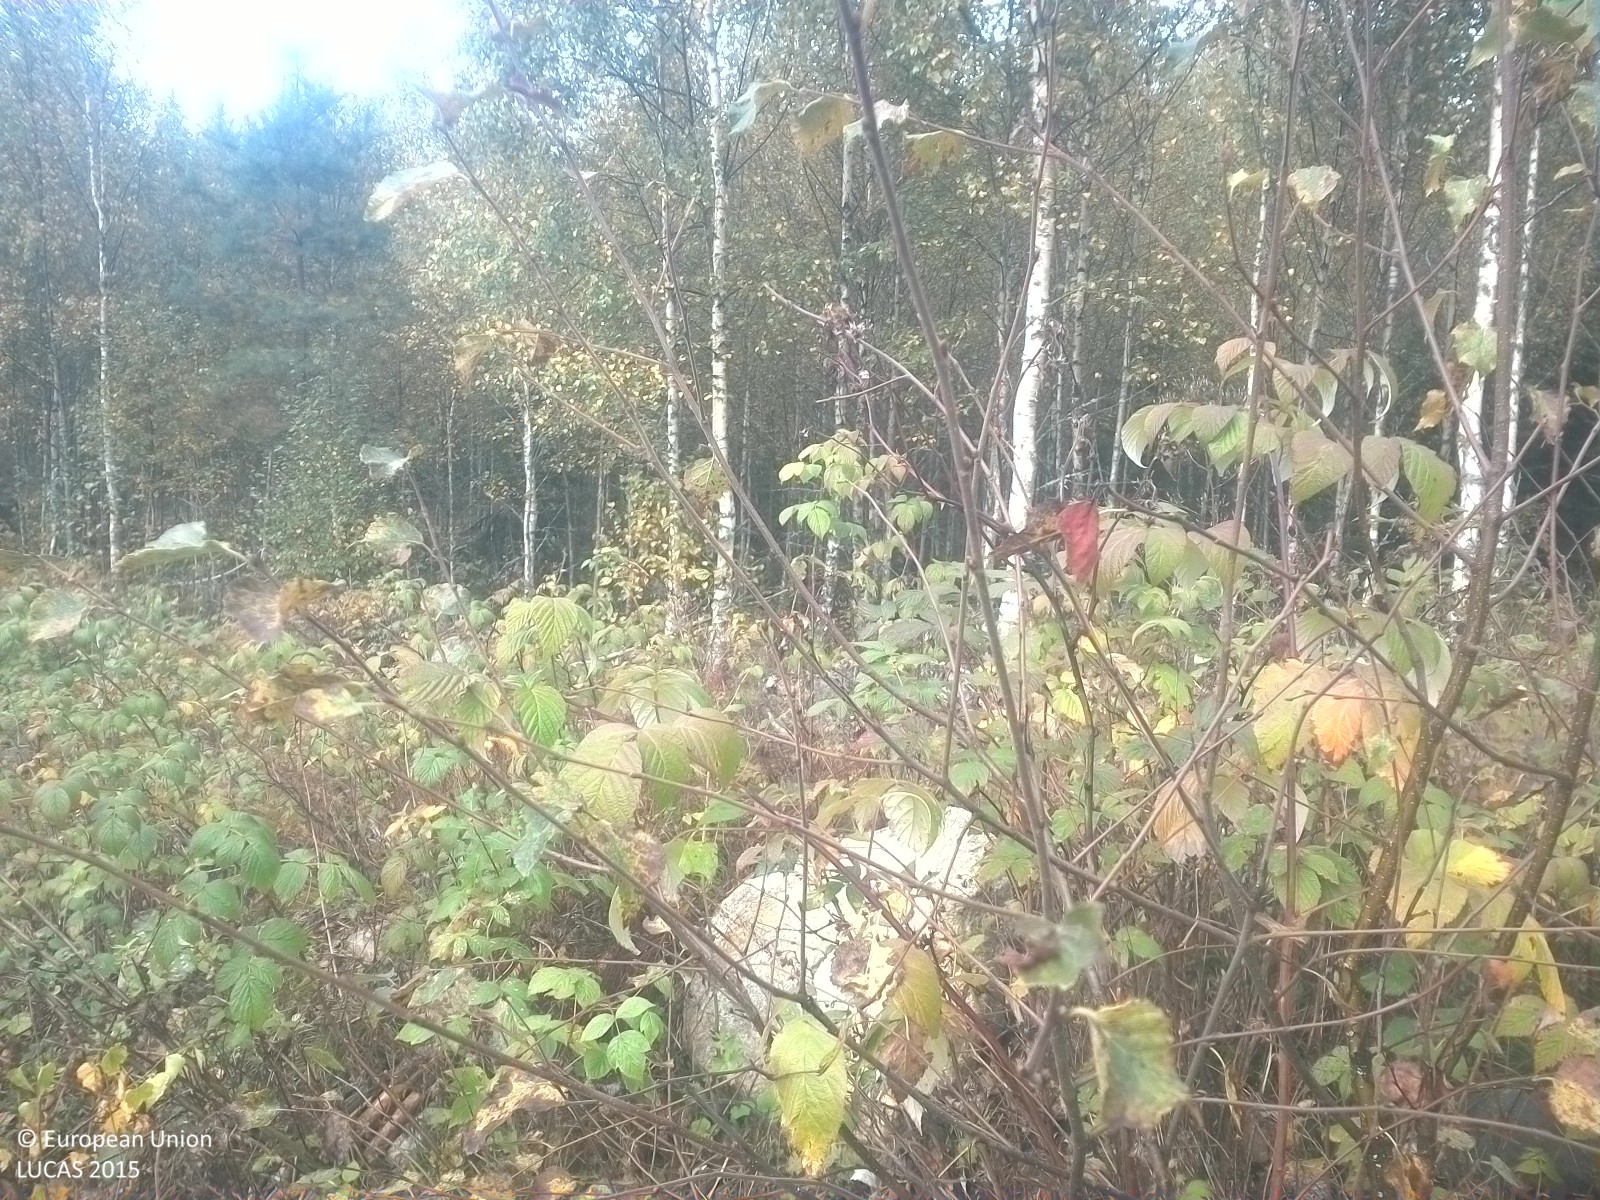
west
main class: Shrubland
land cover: Shrubland with sparse tree cover
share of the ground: > 75 %
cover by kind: shrubs 80 %, herbaceous plants 15 %, broadleaved forest trees 5 %
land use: Semi-natural and natural areas not in use
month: September
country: SE
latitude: 58.8565
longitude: 15.6967
